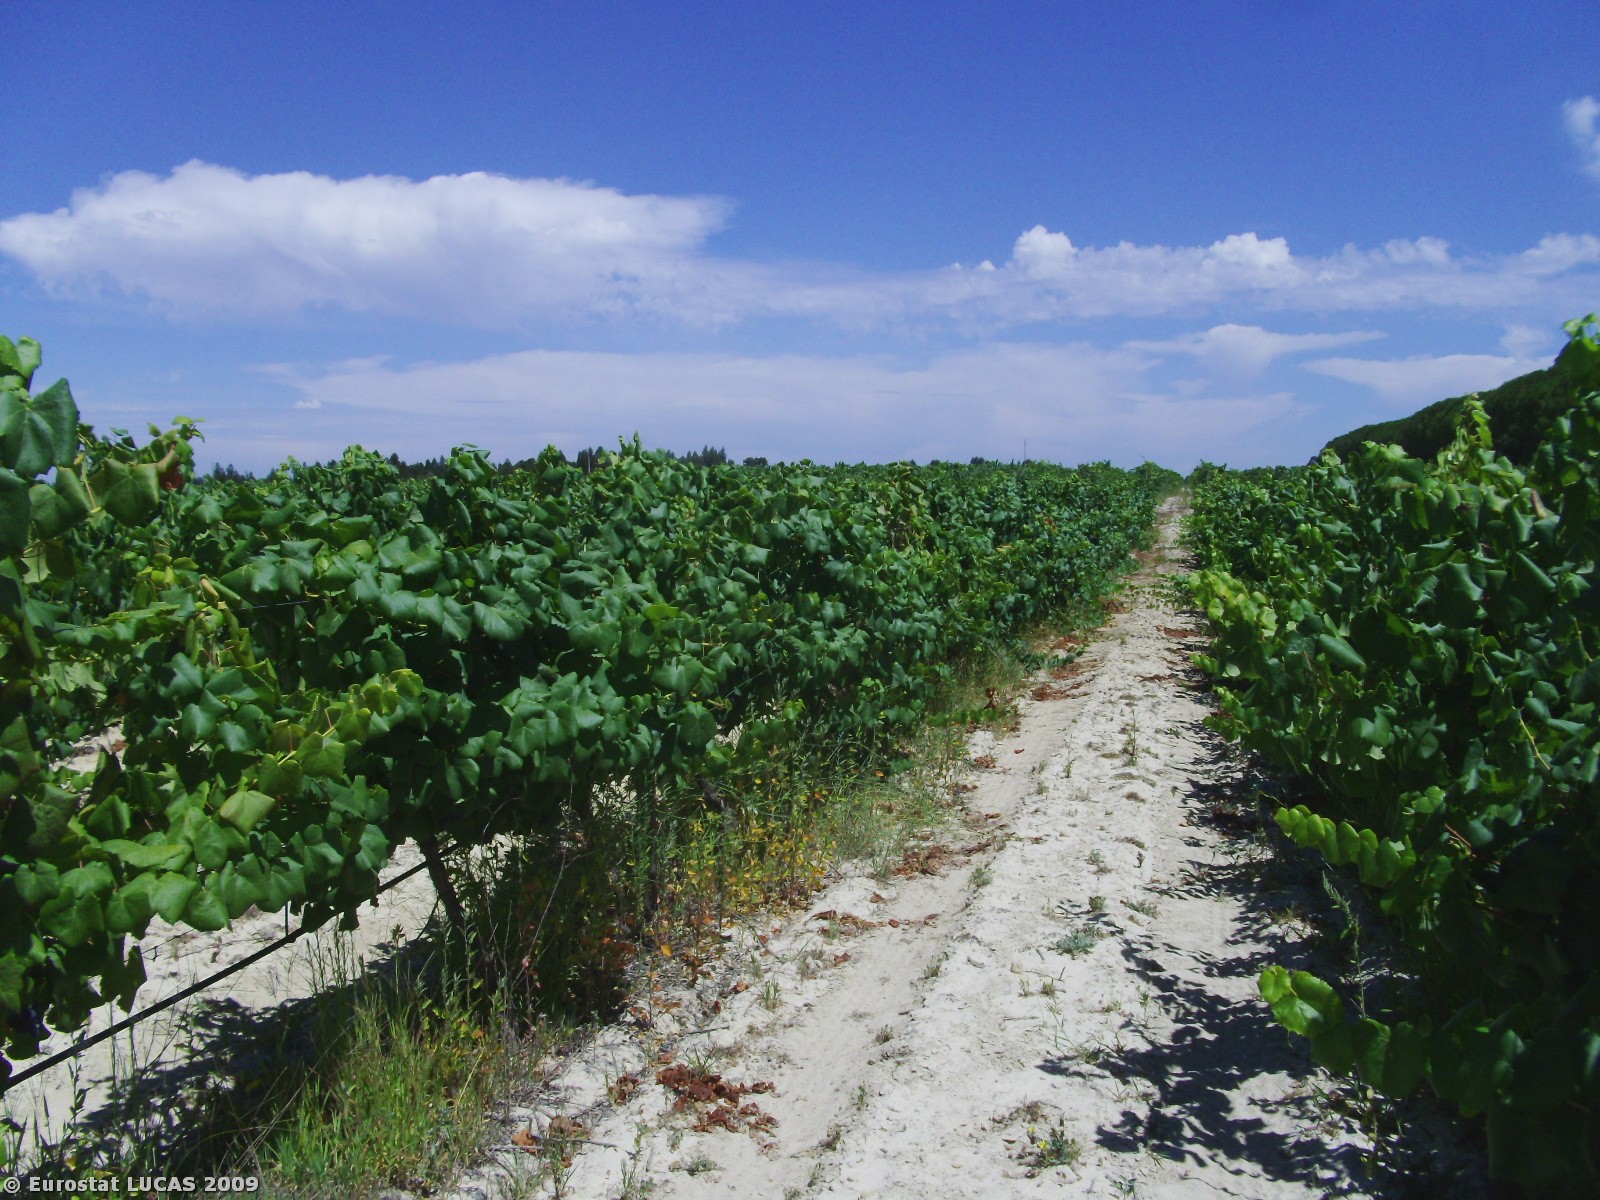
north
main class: Cropland
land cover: Vineyards
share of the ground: 25 - 50 %
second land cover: Bare land
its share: 50 - 75 %
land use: Agriculture (excluding fallow land and kitchen gardens)
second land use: Fallow land
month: August
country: PT
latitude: 38.6614
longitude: -8.6664
